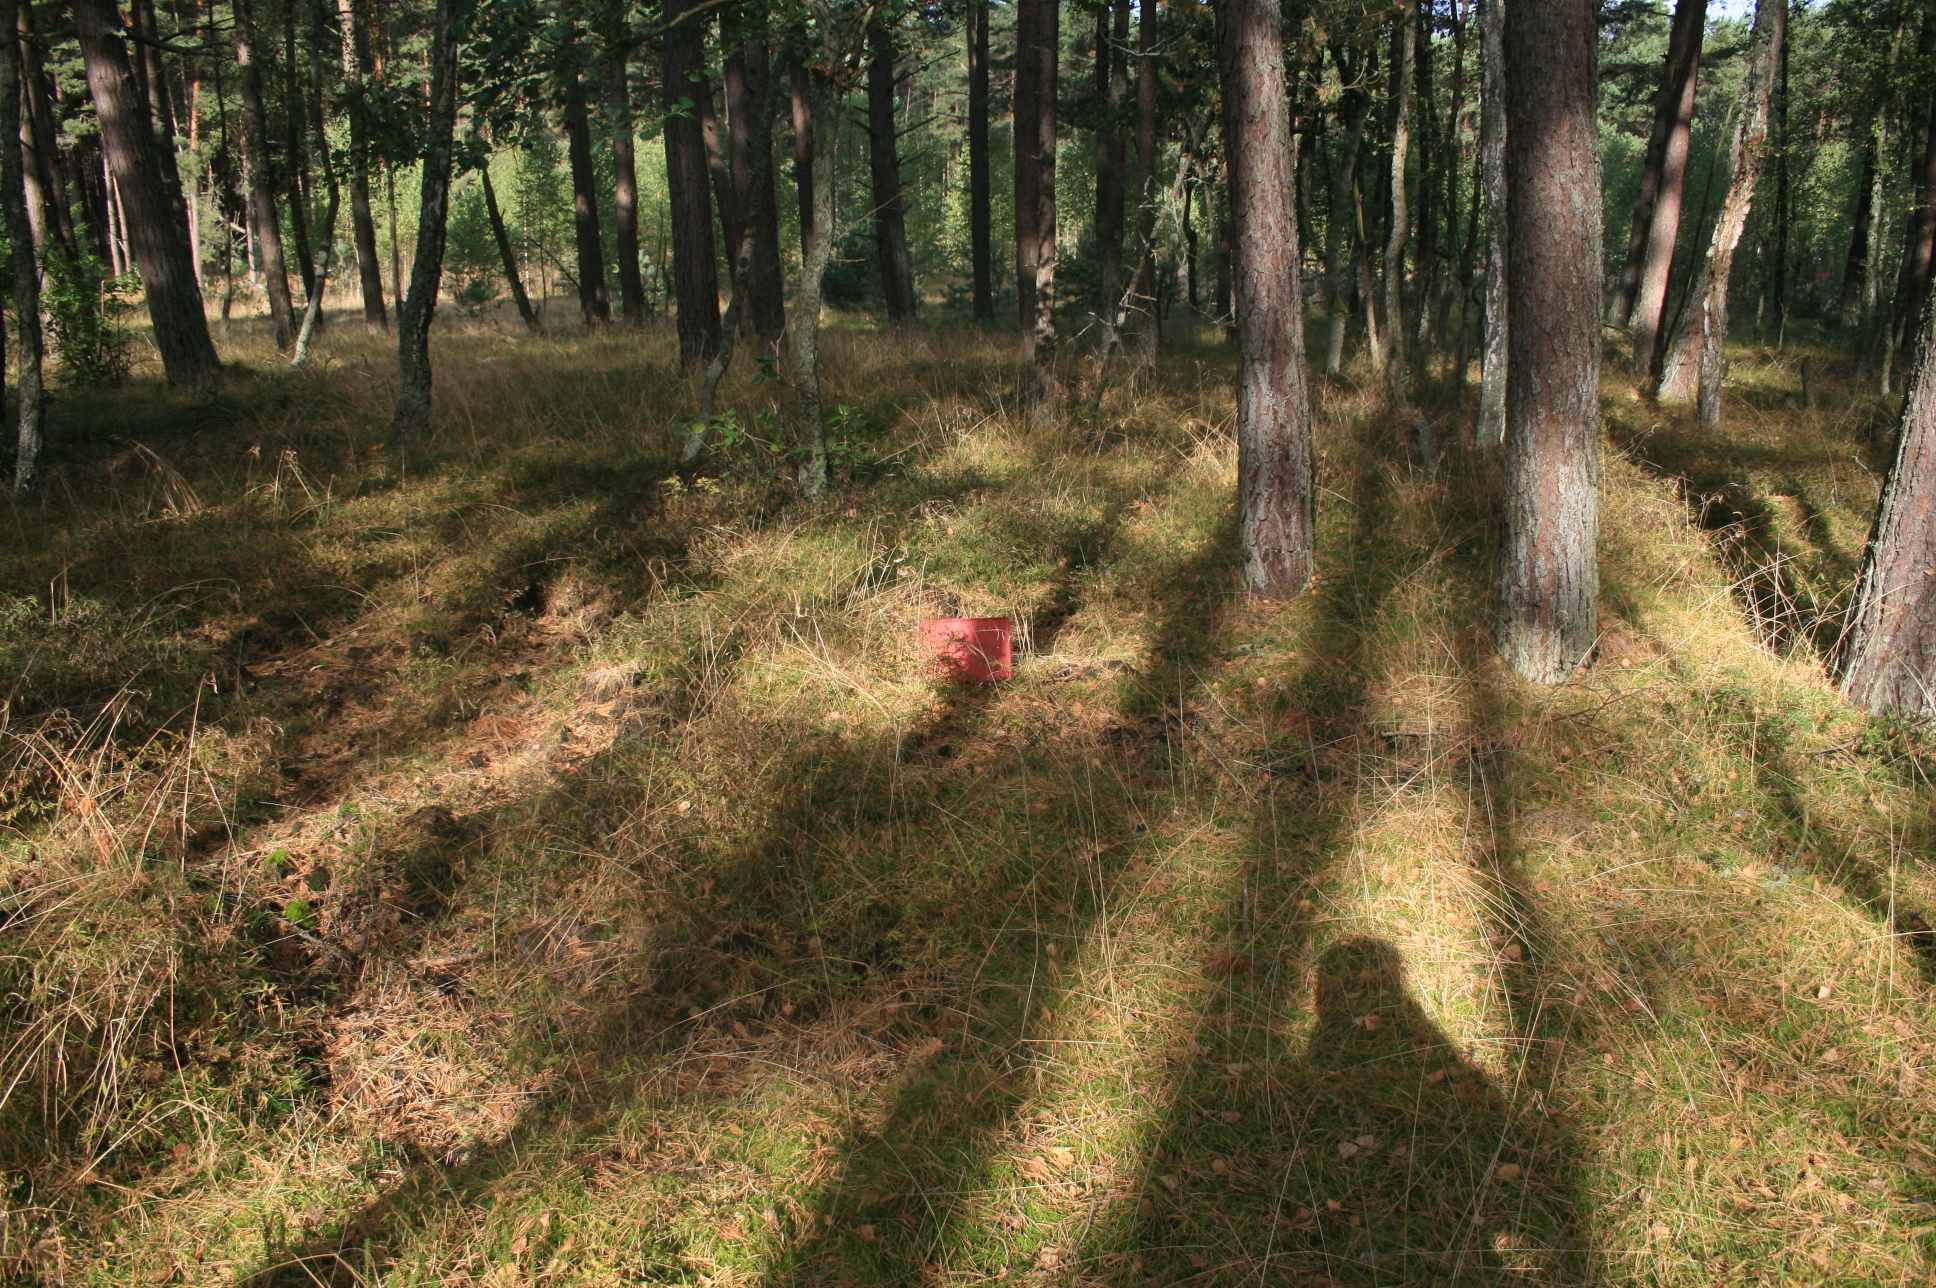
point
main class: Woodland
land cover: Pine dominated coniferous woodland
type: hemiboreal forest and nemoral coniferous forest and mixed broadleaved-coniferous forest
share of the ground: > 75 %
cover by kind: coniferous forest trees 80 %, herbaceous plants 10 %, lichens and mosses 10 %
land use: Forestry
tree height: > 5 m
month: September
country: LT
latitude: 55.3978
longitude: 21.0775
